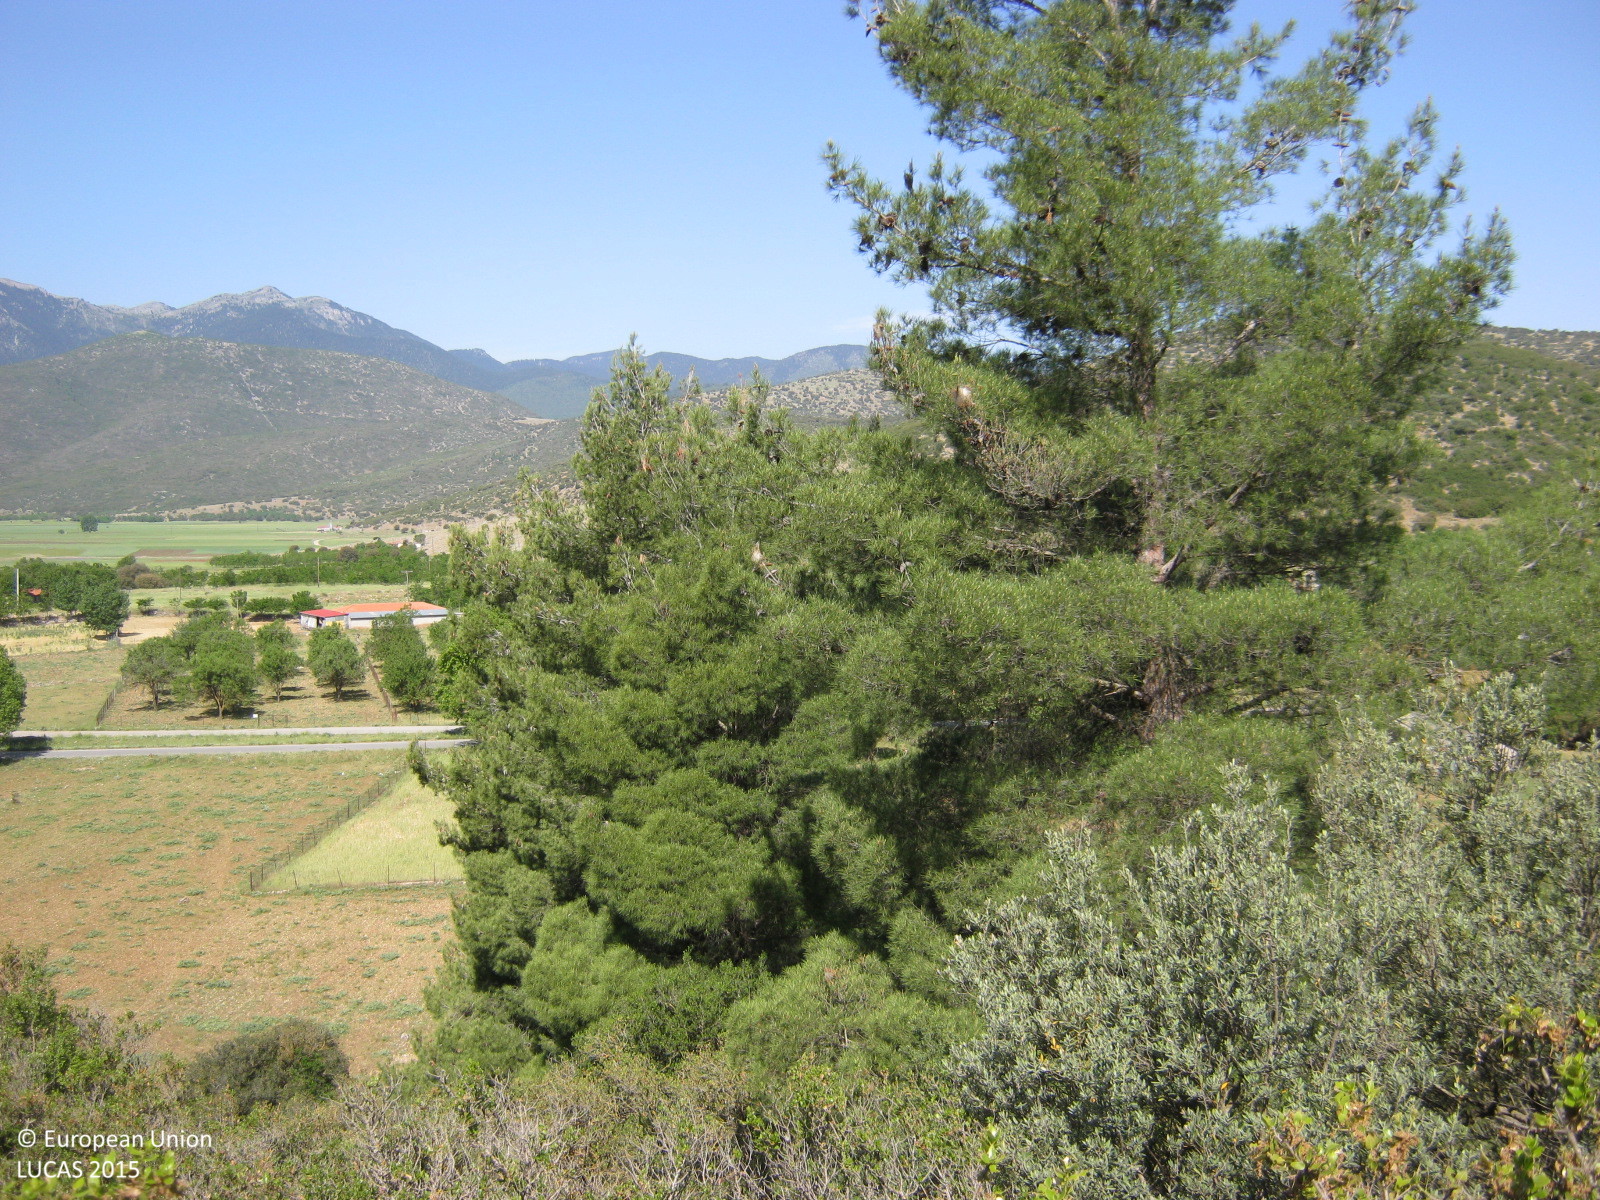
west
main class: Shrubland
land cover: Shrubland with sparse tree cover
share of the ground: 50 - 75 %
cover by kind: shrubs 70 %, herbaceous plants 25 %, coniferous forest trees 5 %
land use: Forestry
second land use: Agriculture (excluding fallow land and kitchen gardens)
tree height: > 5 m
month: May
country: GR
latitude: 37.6684
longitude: 22.3781
